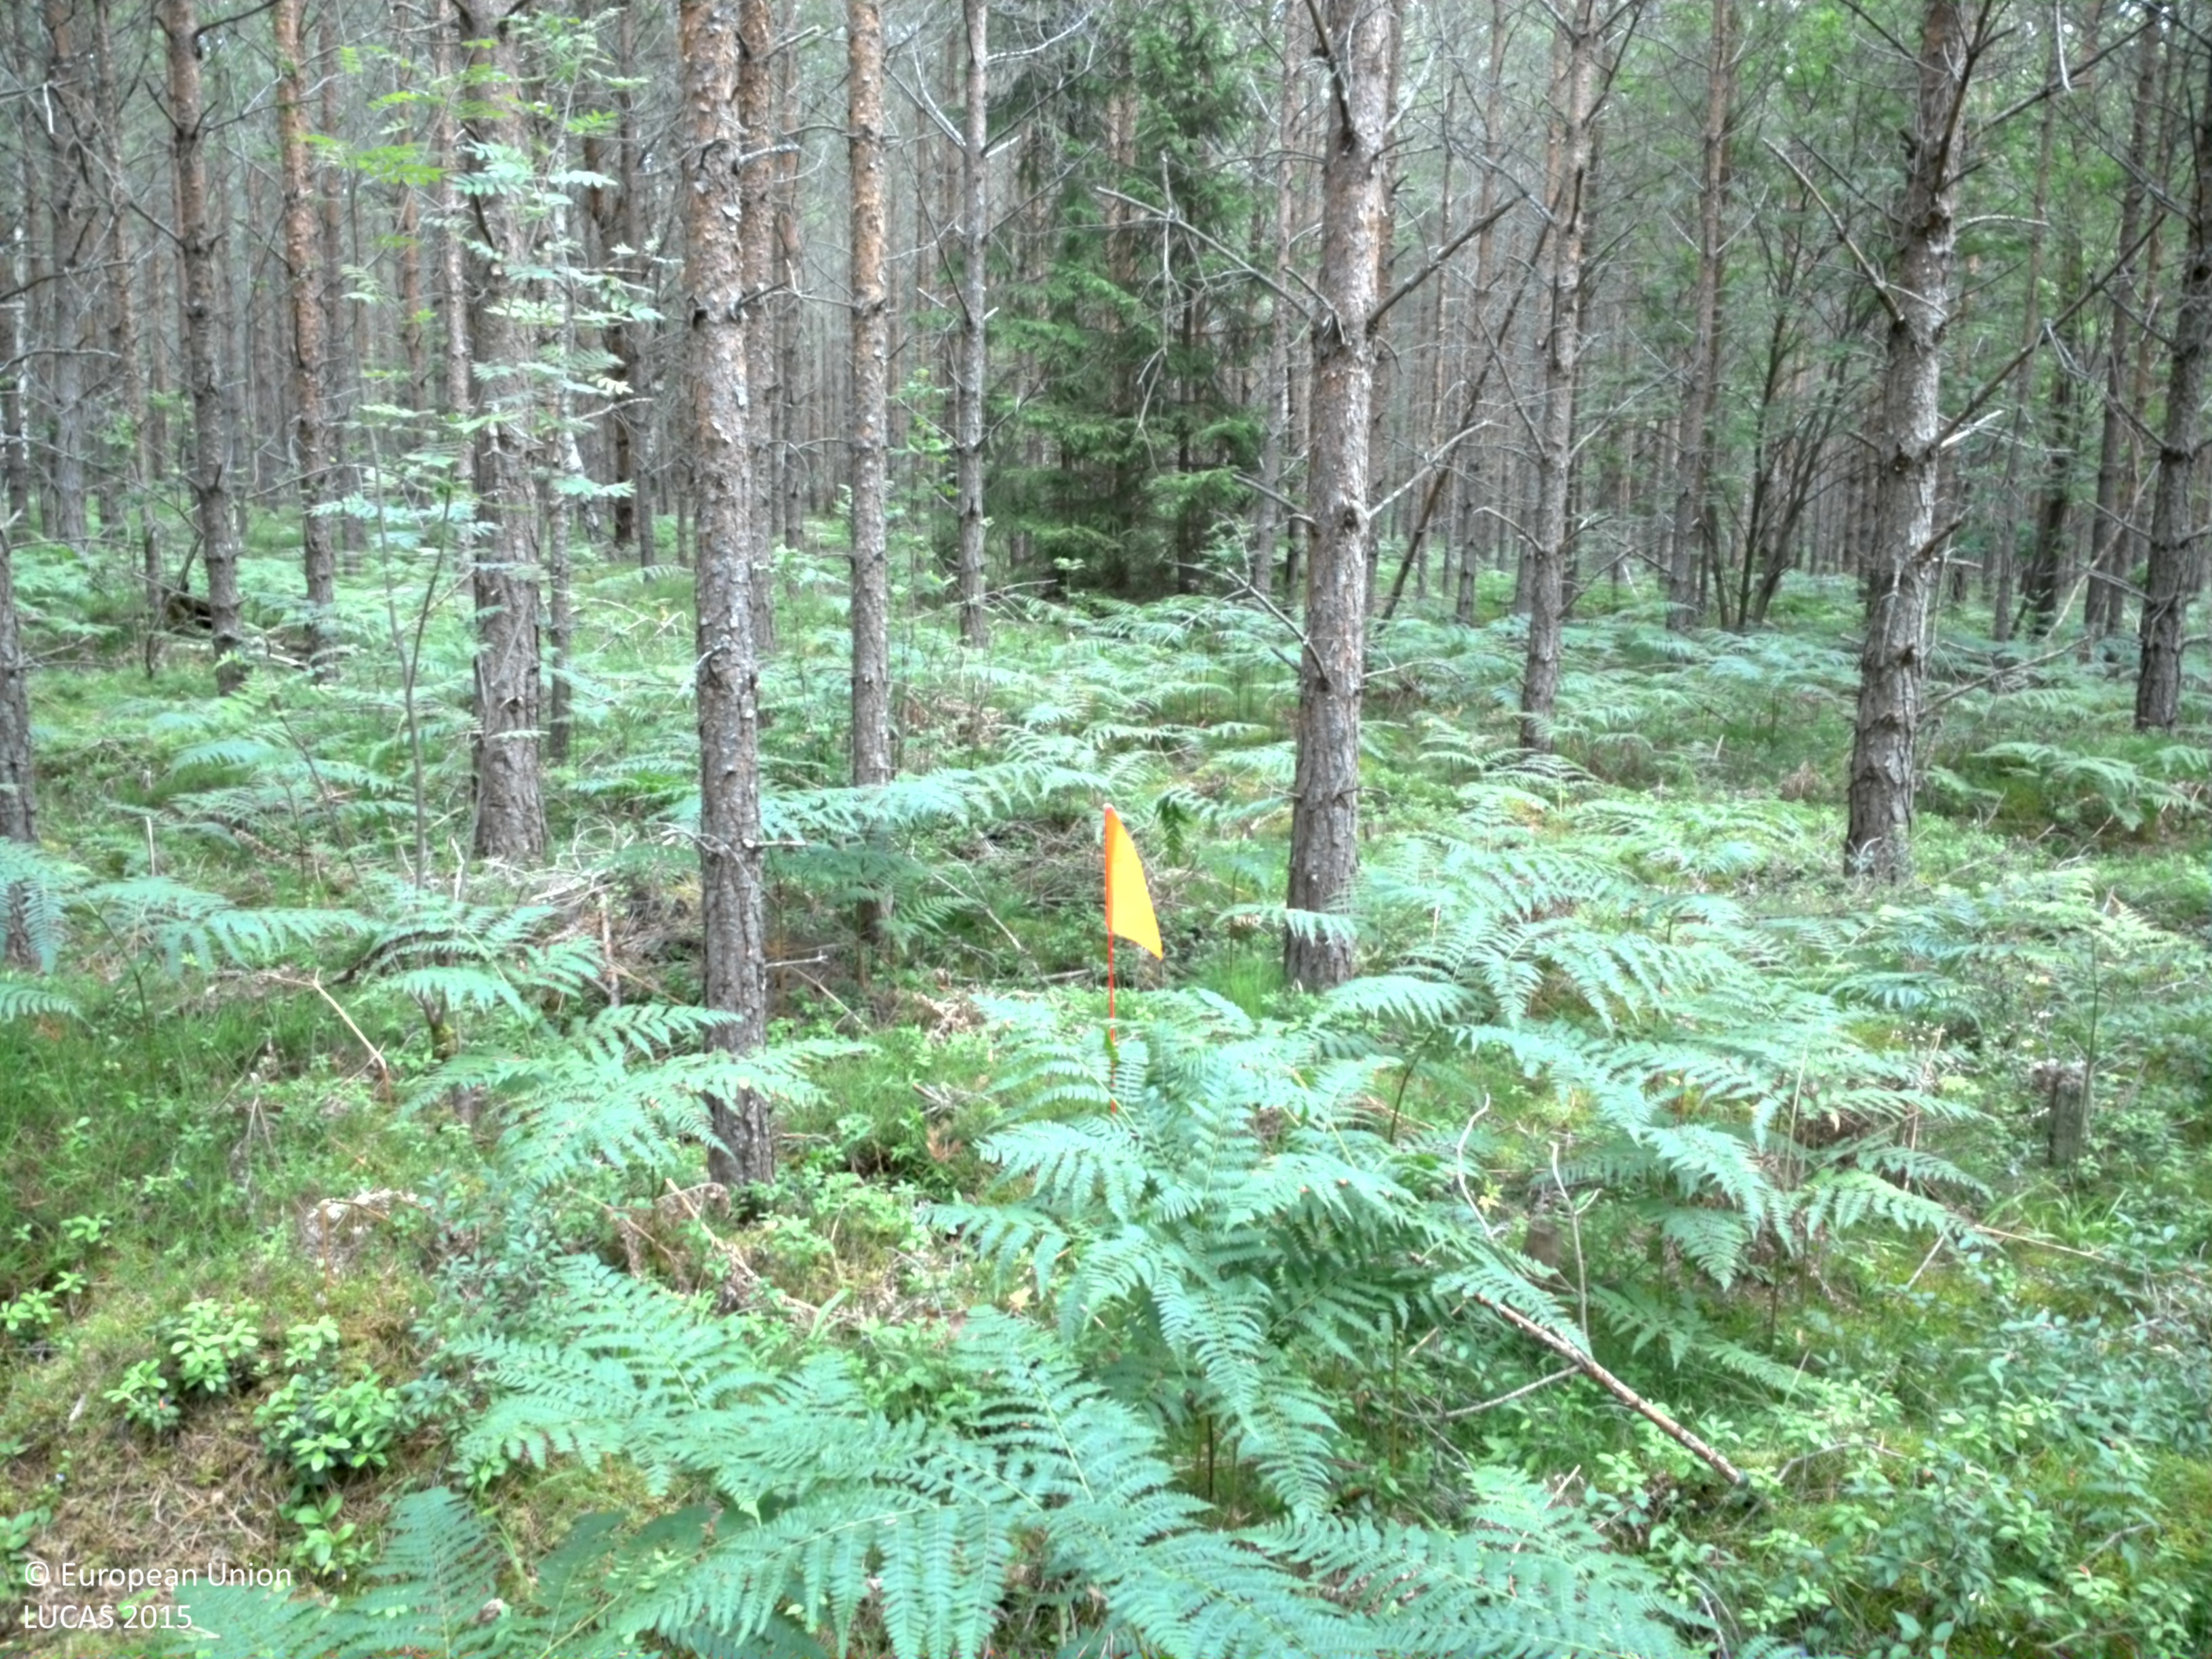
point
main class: Woodland
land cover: Pine dominated coniferous woodland
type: hemiboreal forest and nemoral coniferous forest and mixed broadleaved-coniferous forest
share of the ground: > 75 %
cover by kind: coniferous forest trees 80 %, herbaceous plants 15 %, broadleaved forest trees 5 %
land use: Forestry
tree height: > 5 m
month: July
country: SE
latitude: 57.3554
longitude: 18.7371
